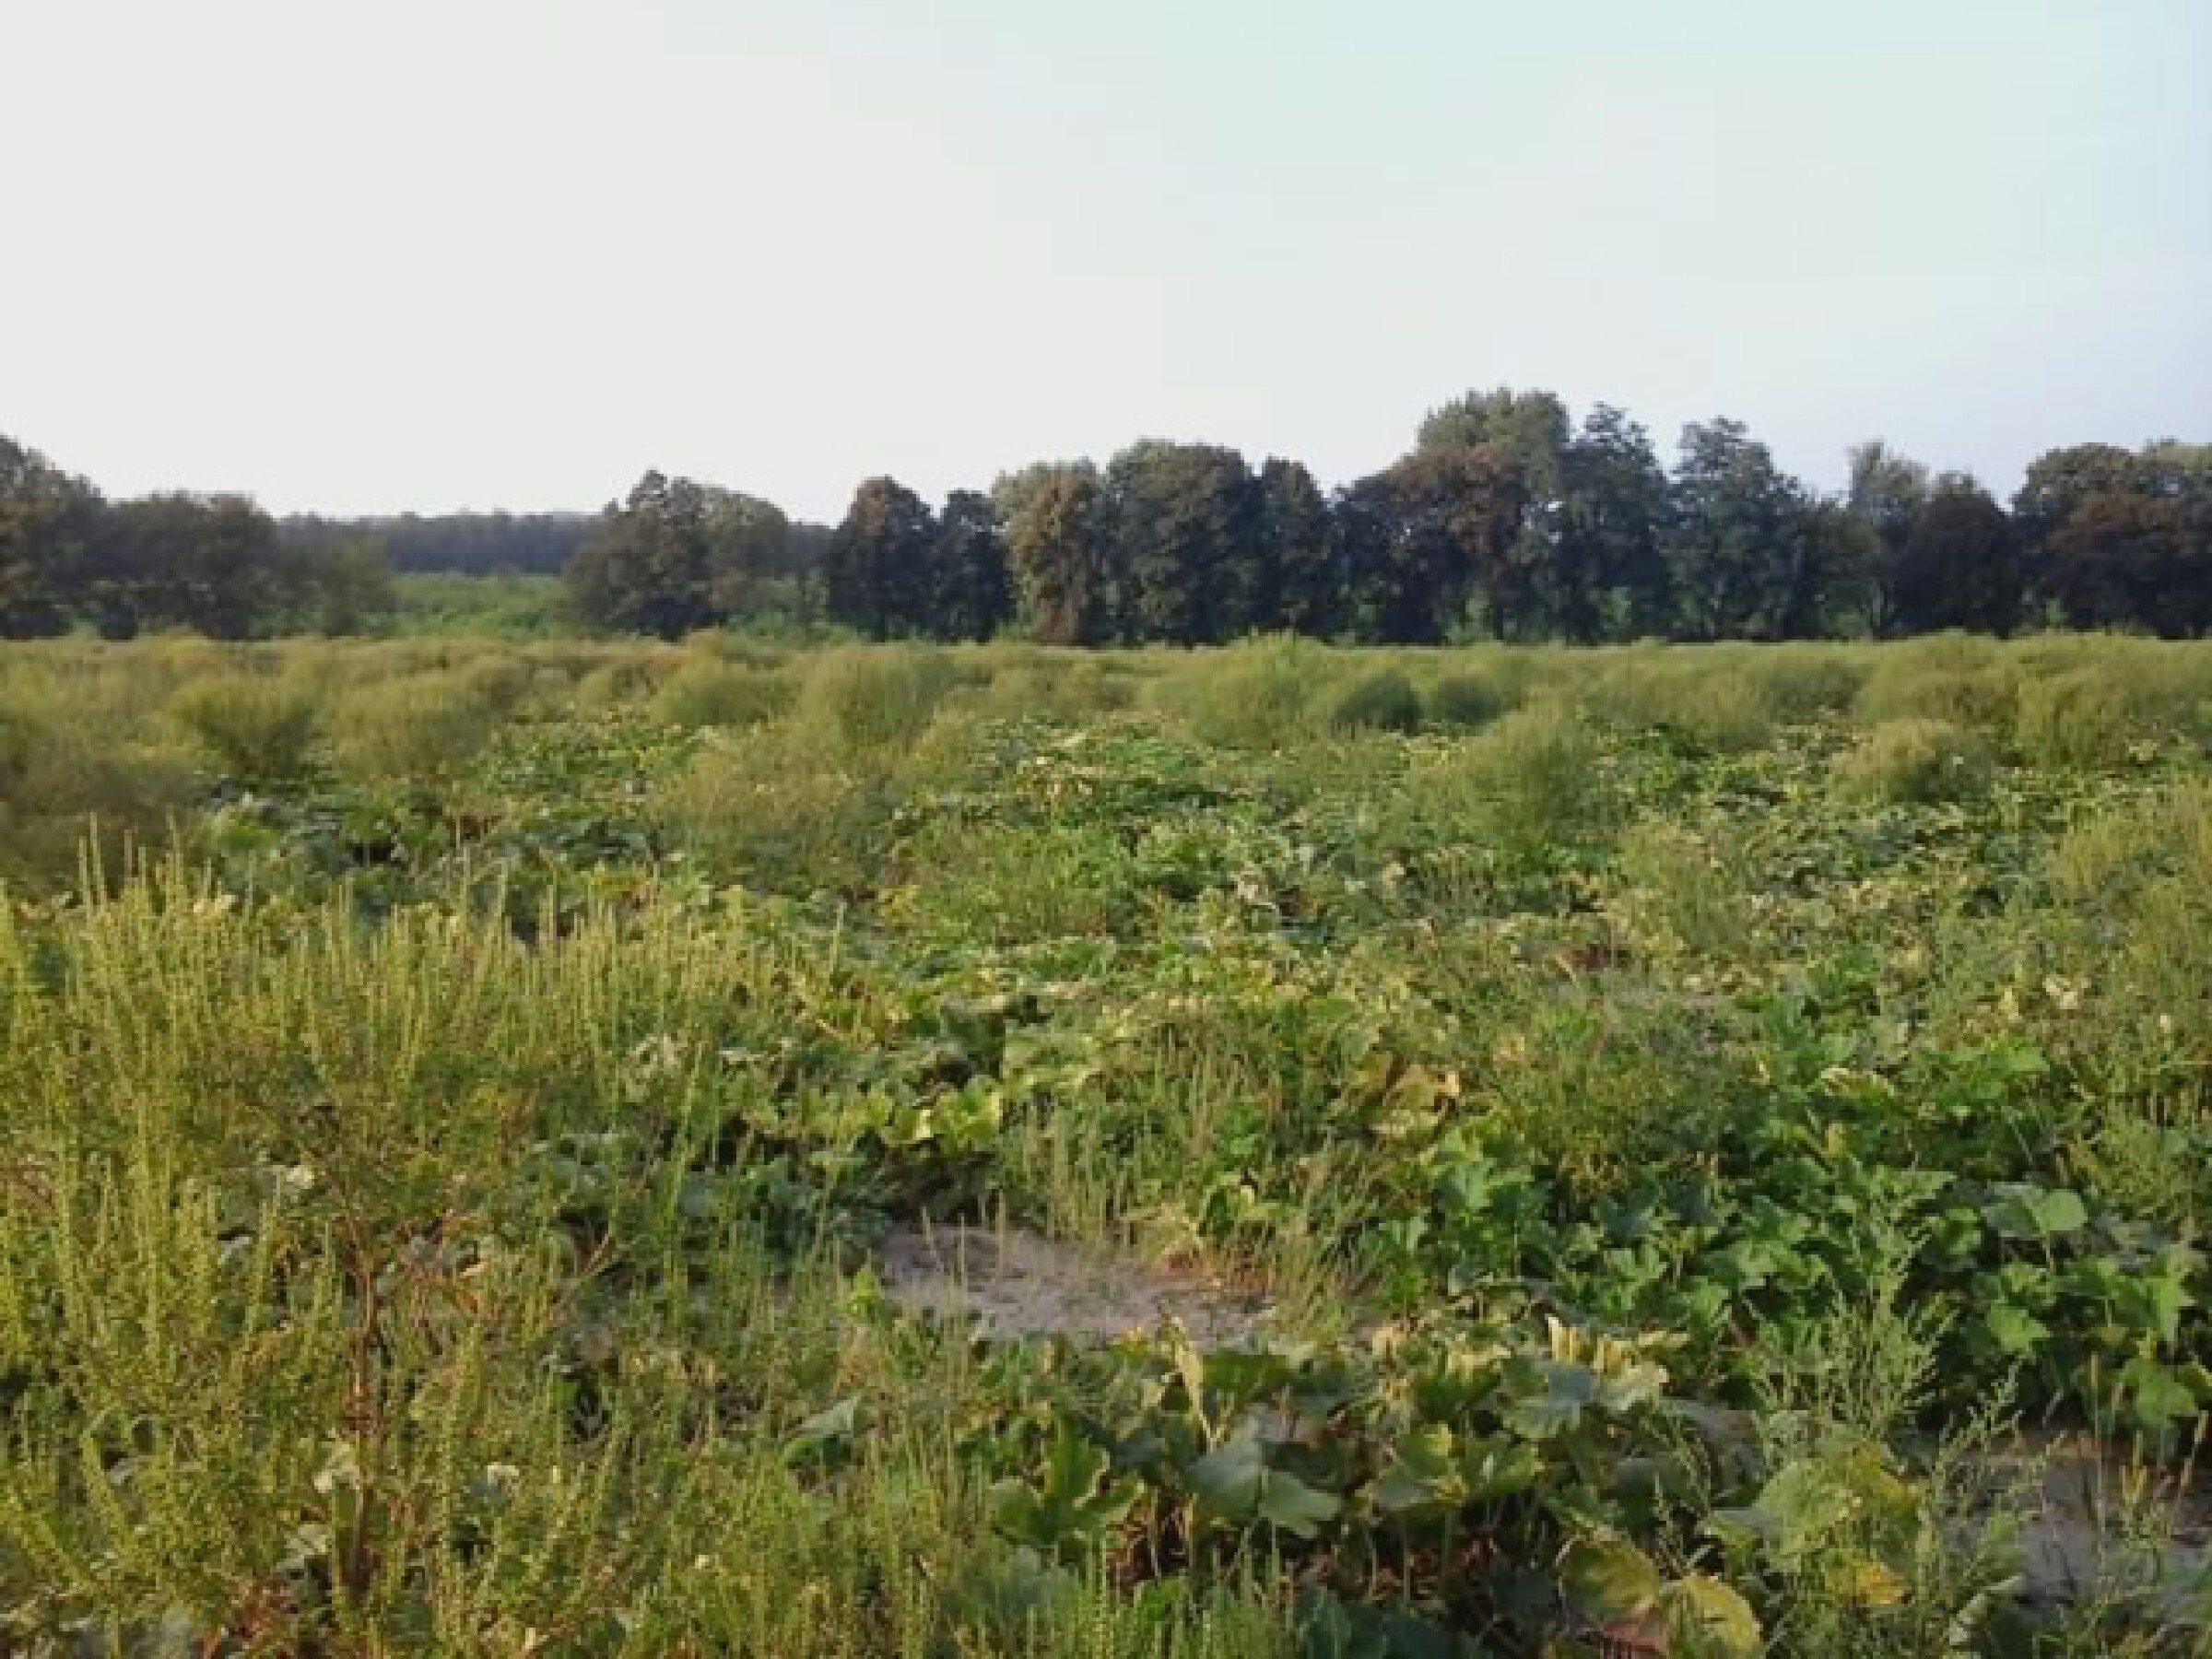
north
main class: Cropland
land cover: Other fresh vegetables
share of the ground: 25 - 50 %
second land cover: Spontaneously vegetated surfaces
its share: 25 - 50 %
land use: Agriculture (excluding fallow land and kitchen gardens)
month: August
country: HU
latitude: 48.0789
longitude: 19.3513
